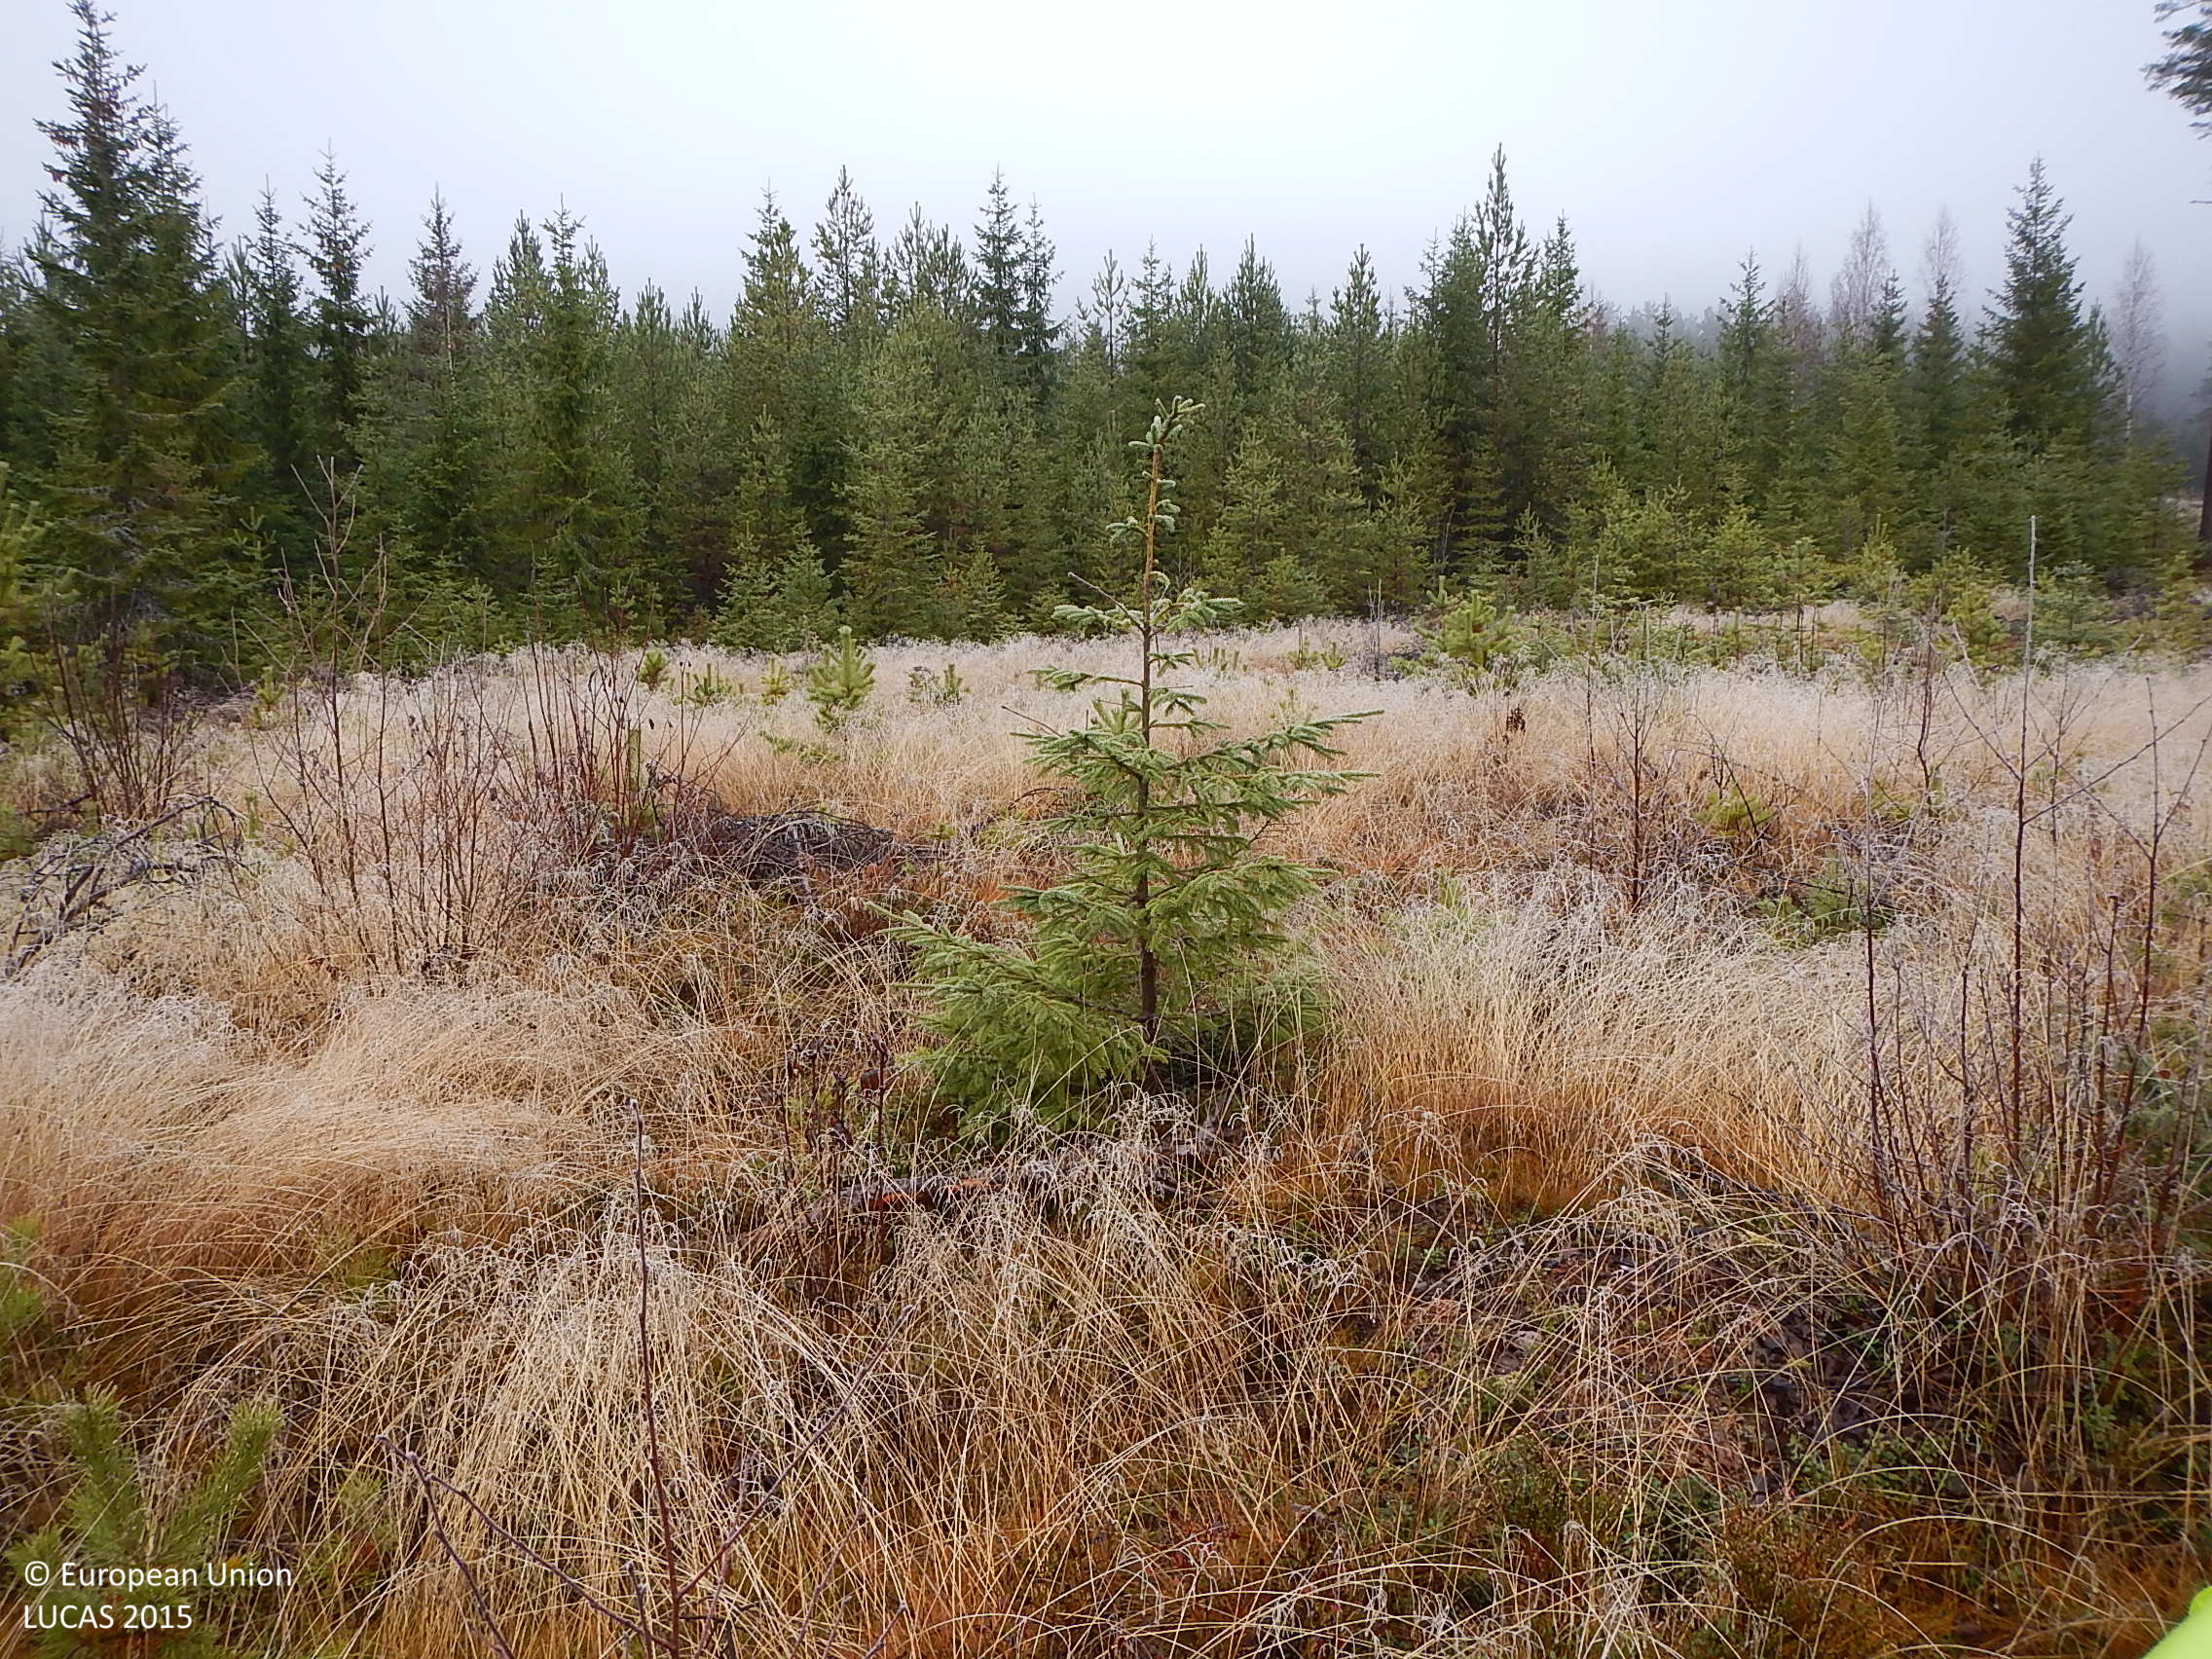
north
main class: Woodland
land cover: Pine dominated coniferous woodland
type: boreal forest
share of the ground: 10 - 25 %
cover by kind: herbaceous plants 55 %, coniferous forest trees 15 %, shrubs 15 %, lichens and mosses 5 %
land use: Forestry
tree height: < 5 m
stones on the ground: < 10 %
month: November
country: SE
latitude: 61.4395
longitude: 16.5283
